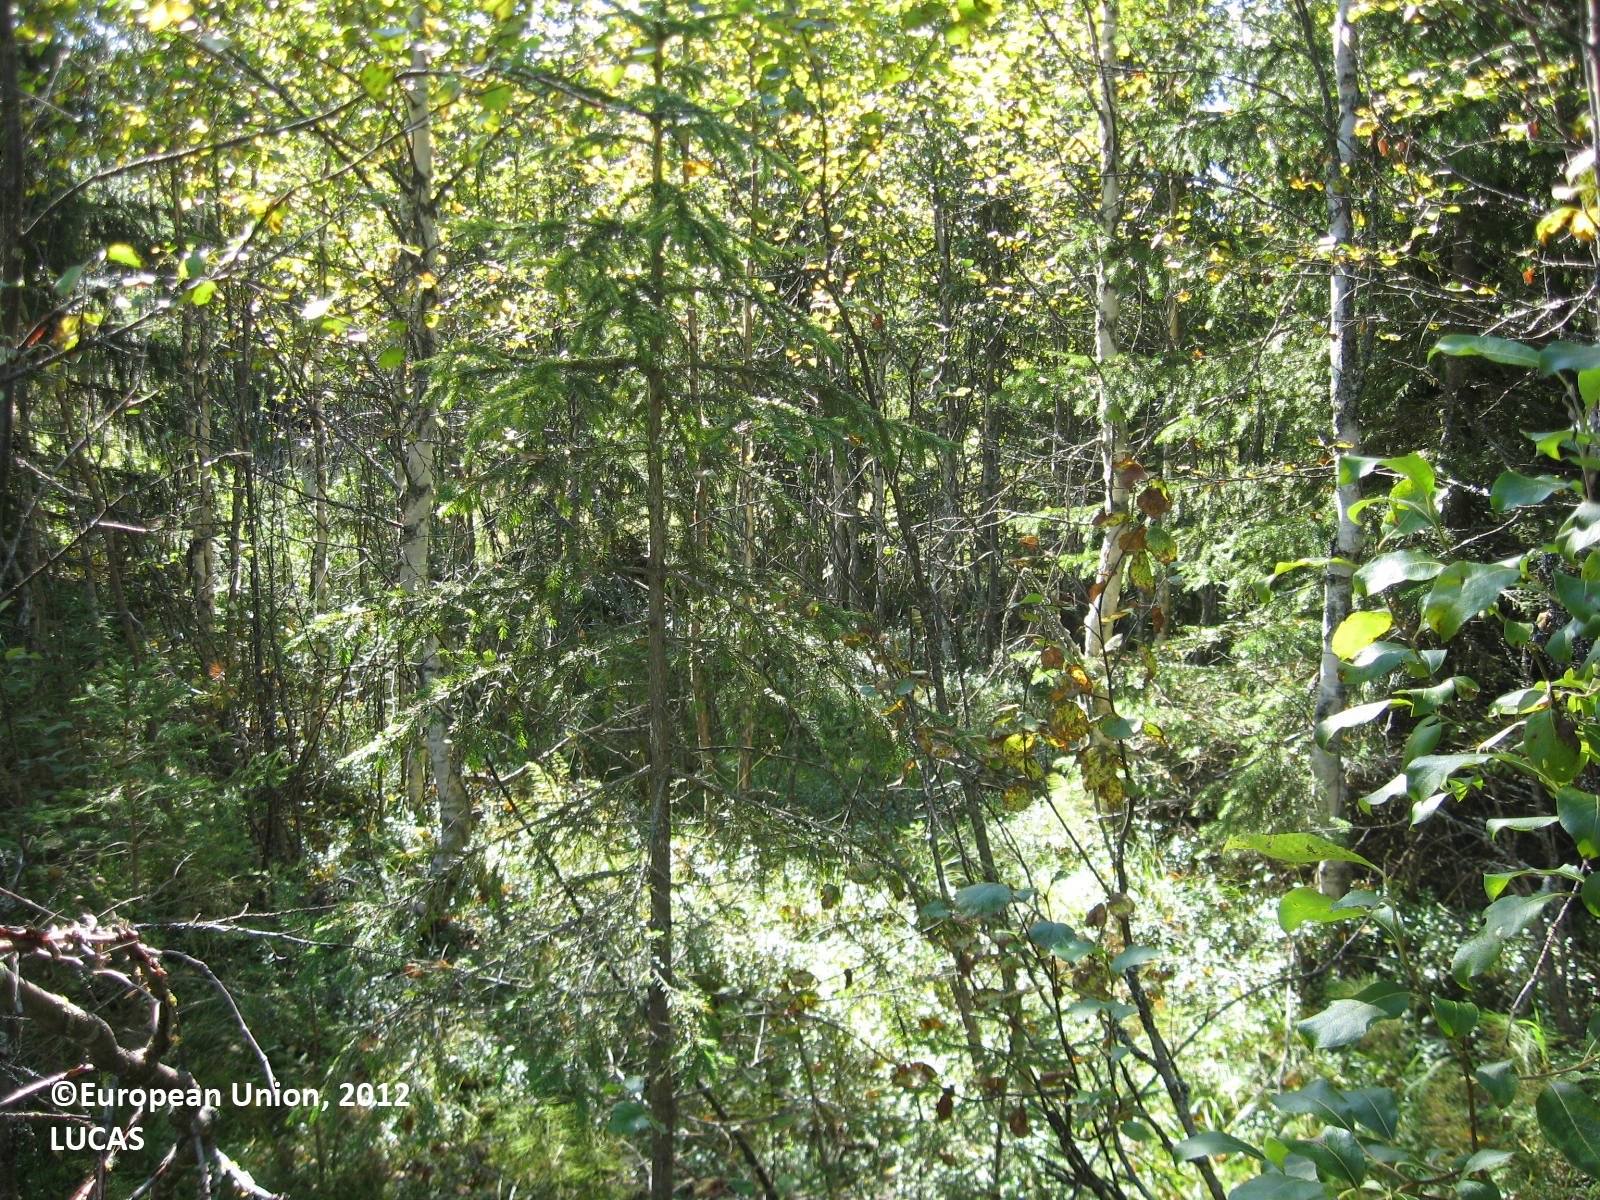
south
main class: Woodland
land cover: Other mixed woodland
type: boreal forest
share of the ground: > 75 %
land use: Forestry
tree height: > 5 m
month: August
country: FI
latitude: 63.8560
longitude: 28.6392
